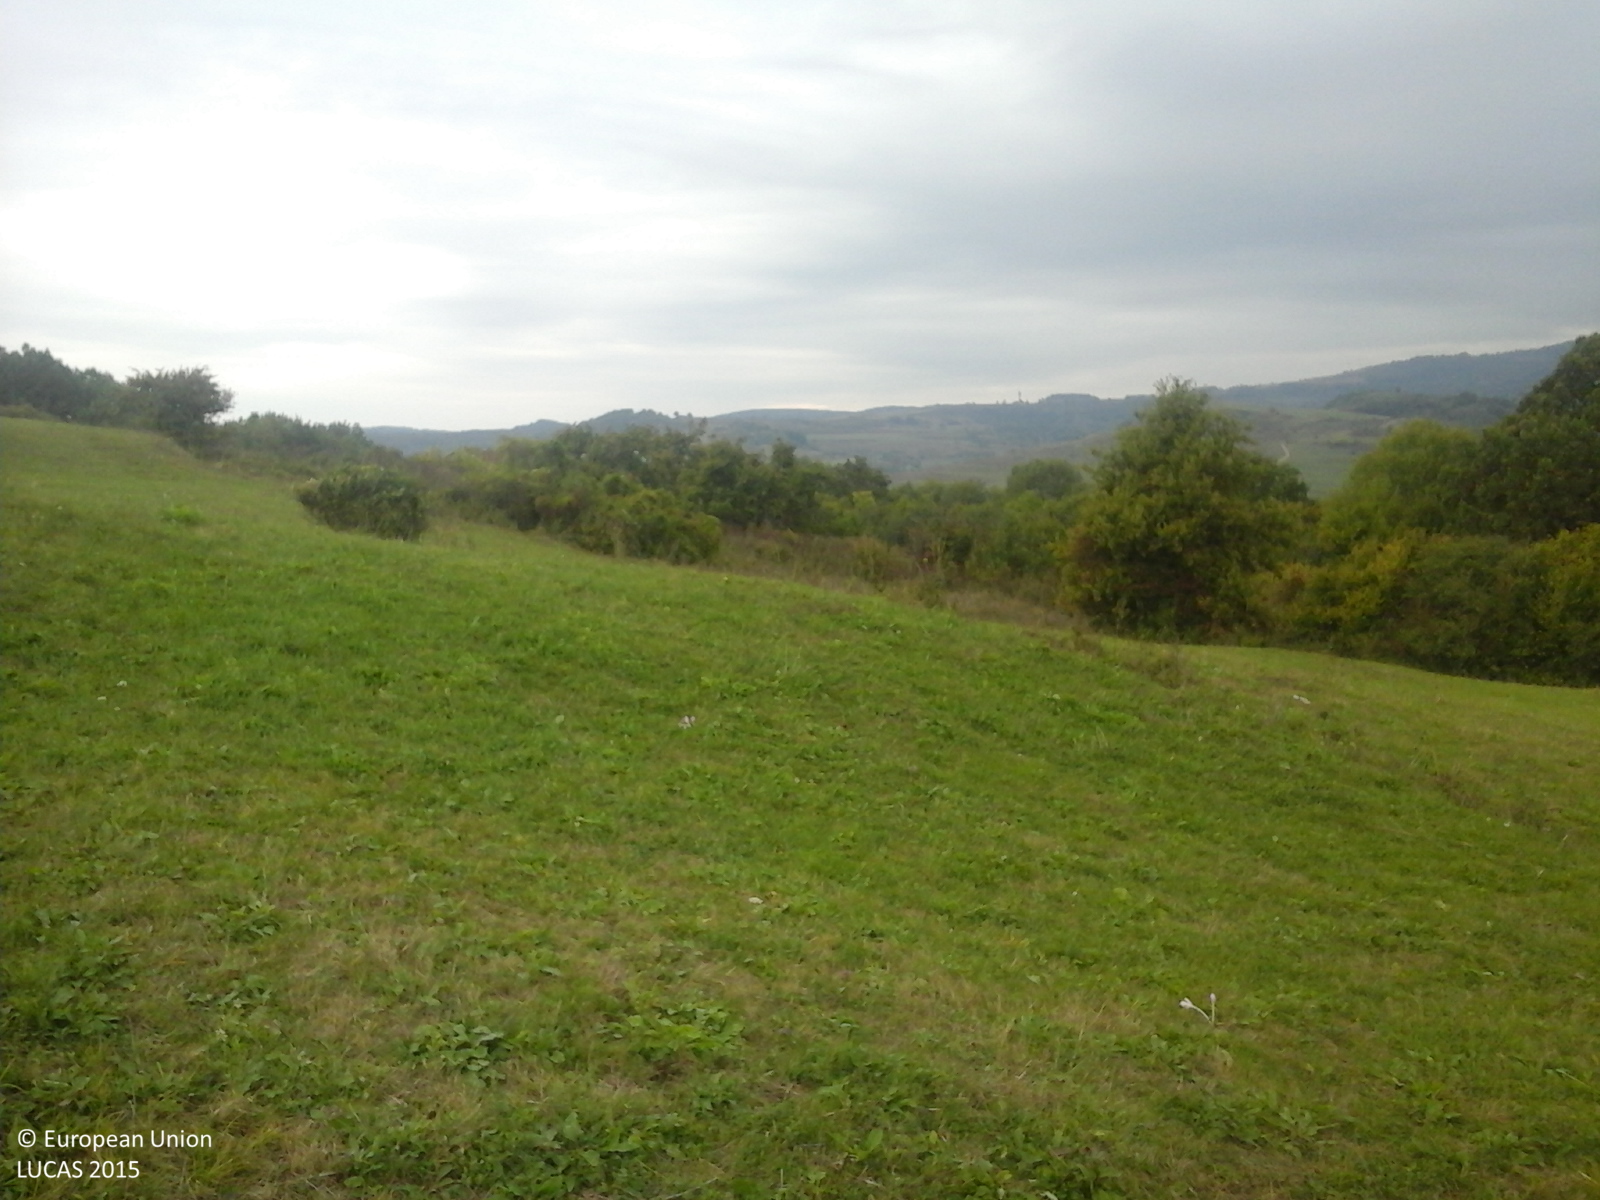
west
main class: Grassland
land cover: Grassland without tree/shrub cover
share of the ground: > 75 %
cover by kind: herbaceous plants 100 %
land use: Agriculture (excluding fallow land and kitchen gardens)
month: October
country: RO
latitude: 46.5624
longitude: 25.0354
